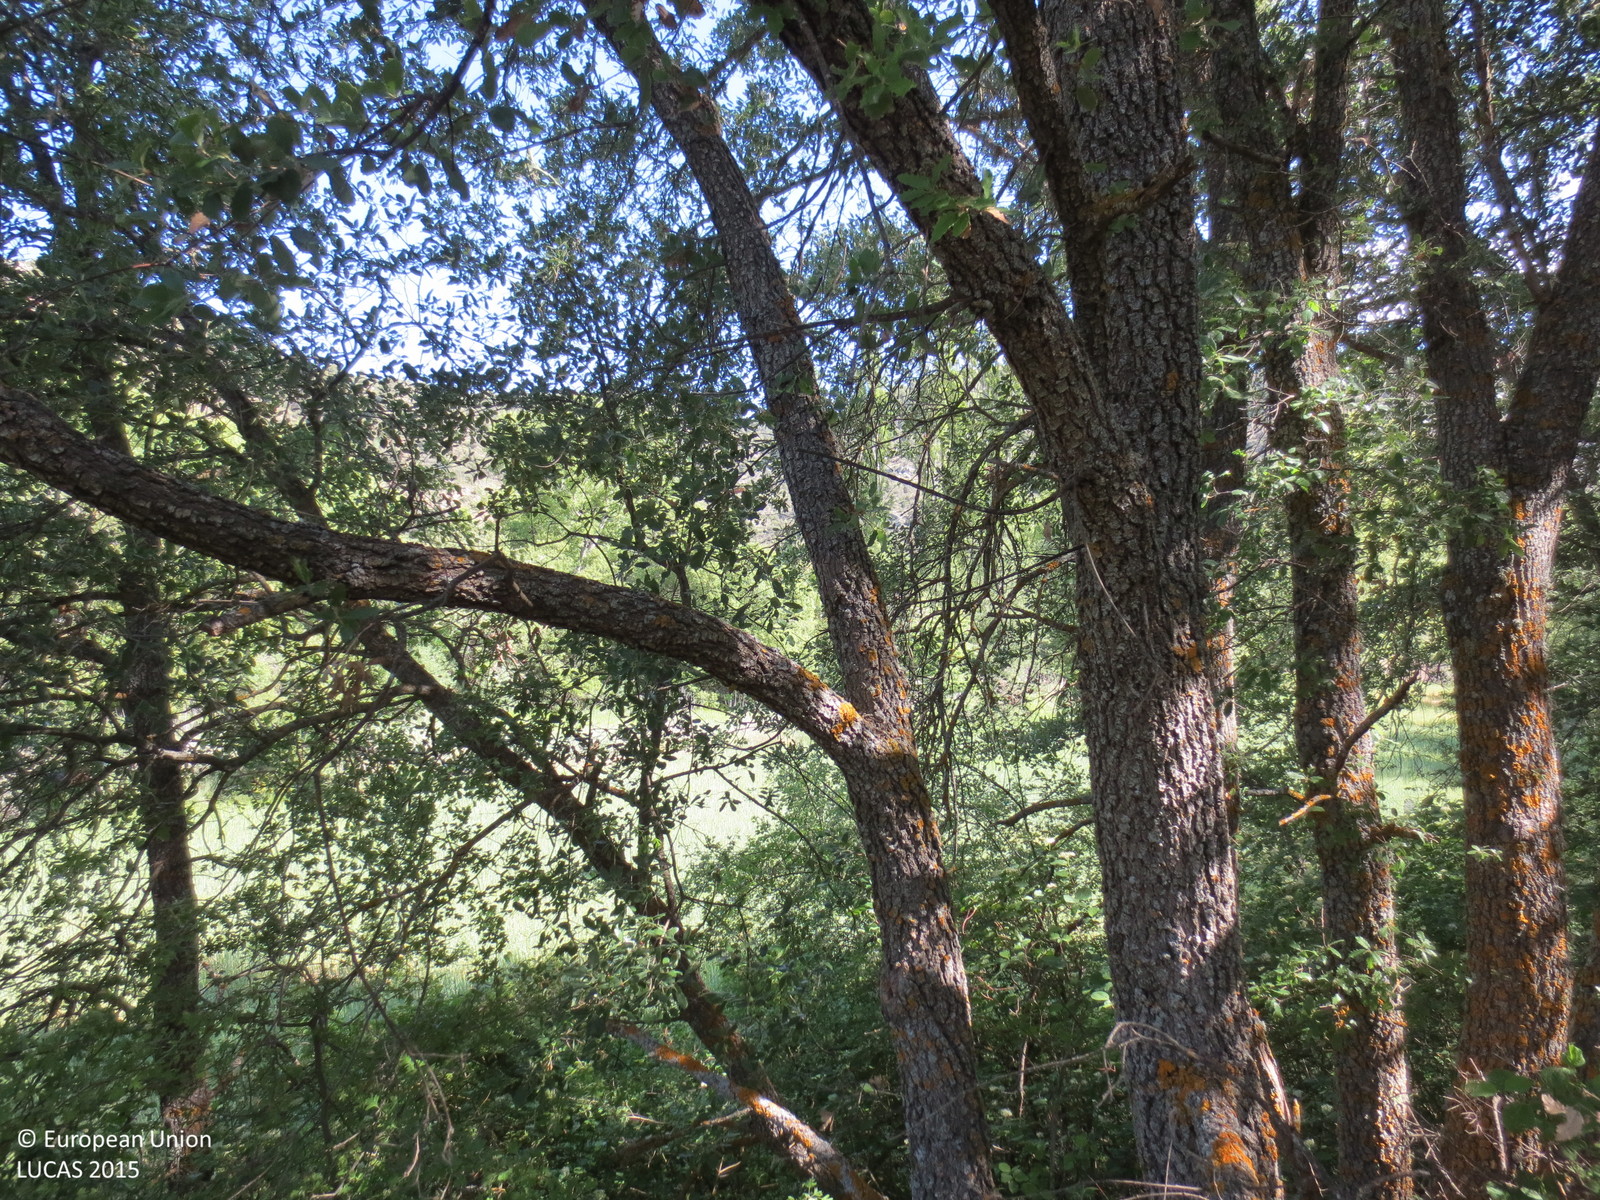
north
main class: Woodland
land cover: Broadleaved woodland
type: thermophilous deciduous forest
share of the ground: 25 - 50 %
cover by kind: broadleaved forest trees 45 %, shrubs 20 %, herbaceous plants 20 %, consolidated bare surface 10 %, coniferous forest trees 5 %
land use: Semi-natural and natural areas not in use
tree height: < 5 m
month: May
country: ES
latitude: 40.6434
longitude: -2.5731
